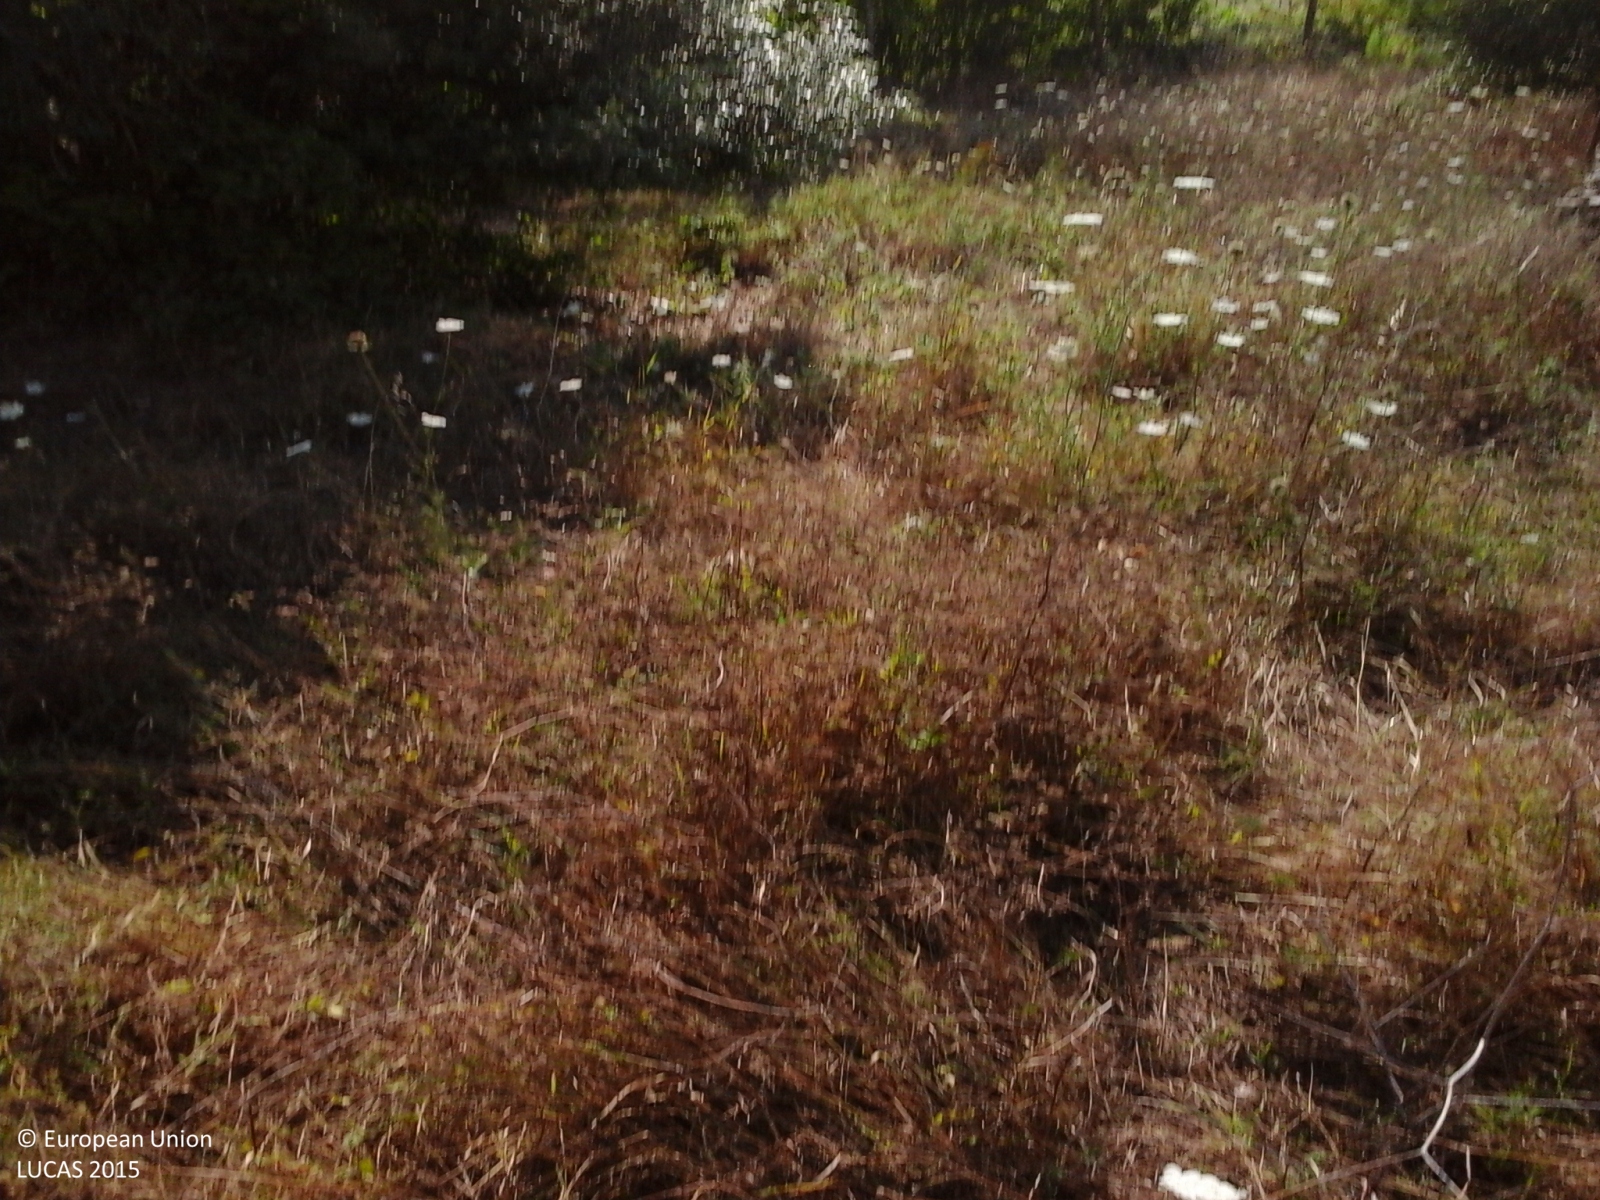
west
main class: Cropland
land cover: Olive groves
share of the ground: > 75 %
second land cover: Temporary grasslands
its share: > 75 %
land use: Agriculture (excluding fallow land and kitchen gardens)
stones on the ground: < 10 %
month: July
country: IT
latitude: 43.0405
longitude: 11.4807
